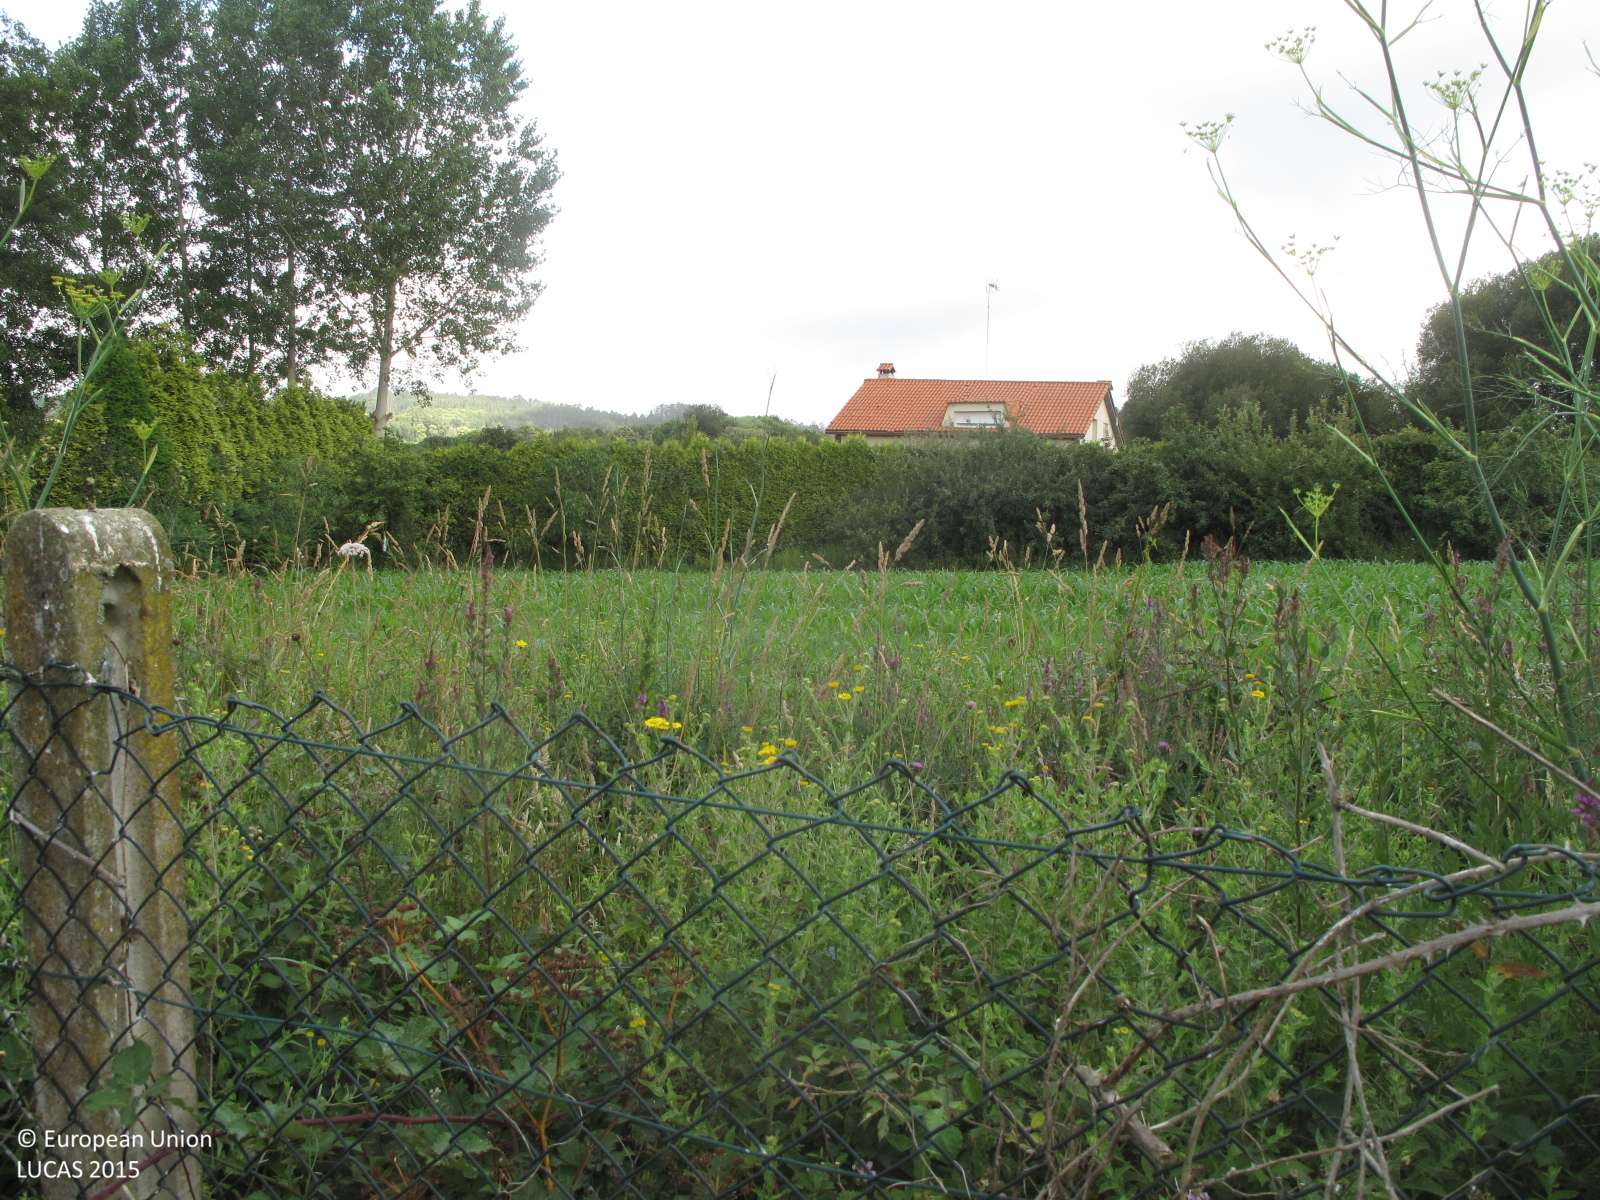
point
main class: Cropland
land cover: Maize
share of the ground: 25 - 50 %
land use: Agriculture (excluding fallow land and kitchen gardens)
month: July
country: ES
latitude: 43.3563
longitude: -8.2770
